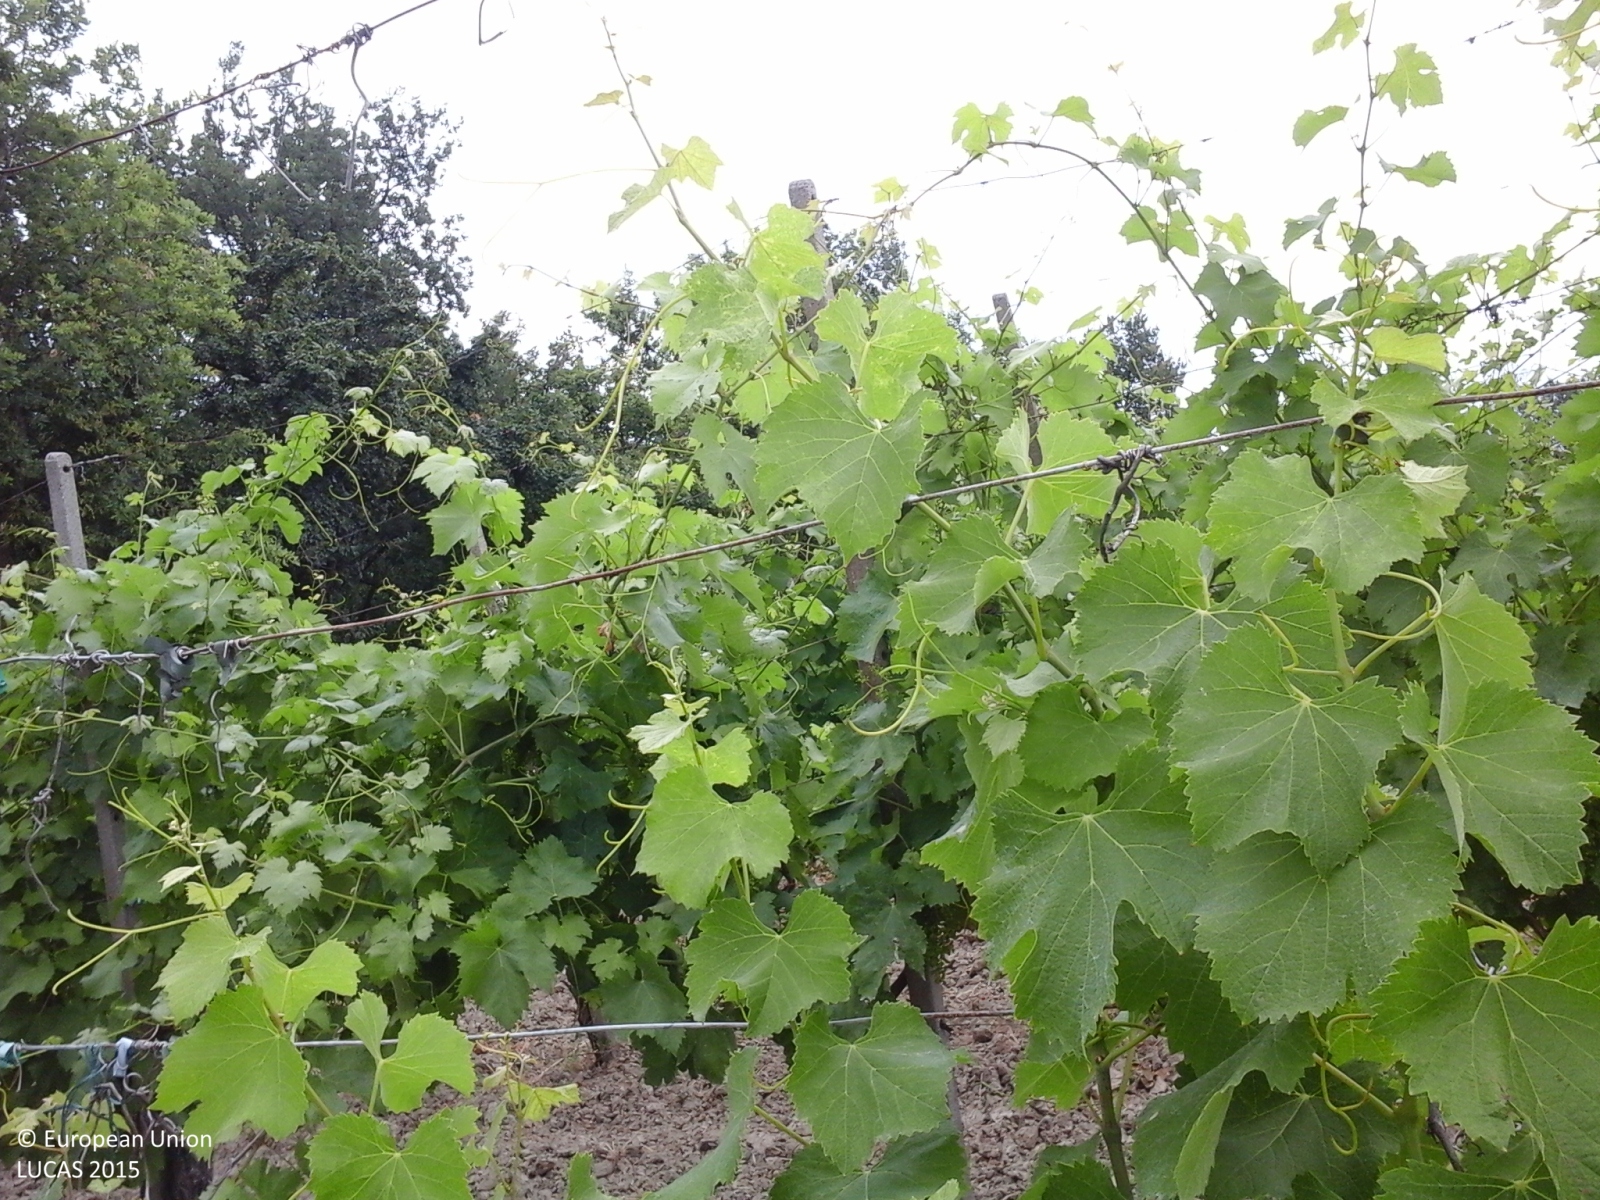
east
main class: Cropland
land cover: Vineyards
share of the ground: < 10 %
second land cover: Other bare soil
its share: > 75 %
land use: Agriculture (excluding fallow land and kitchen gardens)
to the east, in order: Vineyards; Other bare soil; Tracks; Managed hedges; Paved roads, cycling and walking lanes; Broadleaved woodland; Lucerne; Broadleaved woodland; Paved roads, cycling and walking lanes; Broadleaved woodland; Vineyards; Broadleaved woodland; Paved roads, cycling and walking lanes; Fences; Broadleaved woodland
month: June
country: IT
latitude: 44.8374
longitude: 9.8864
